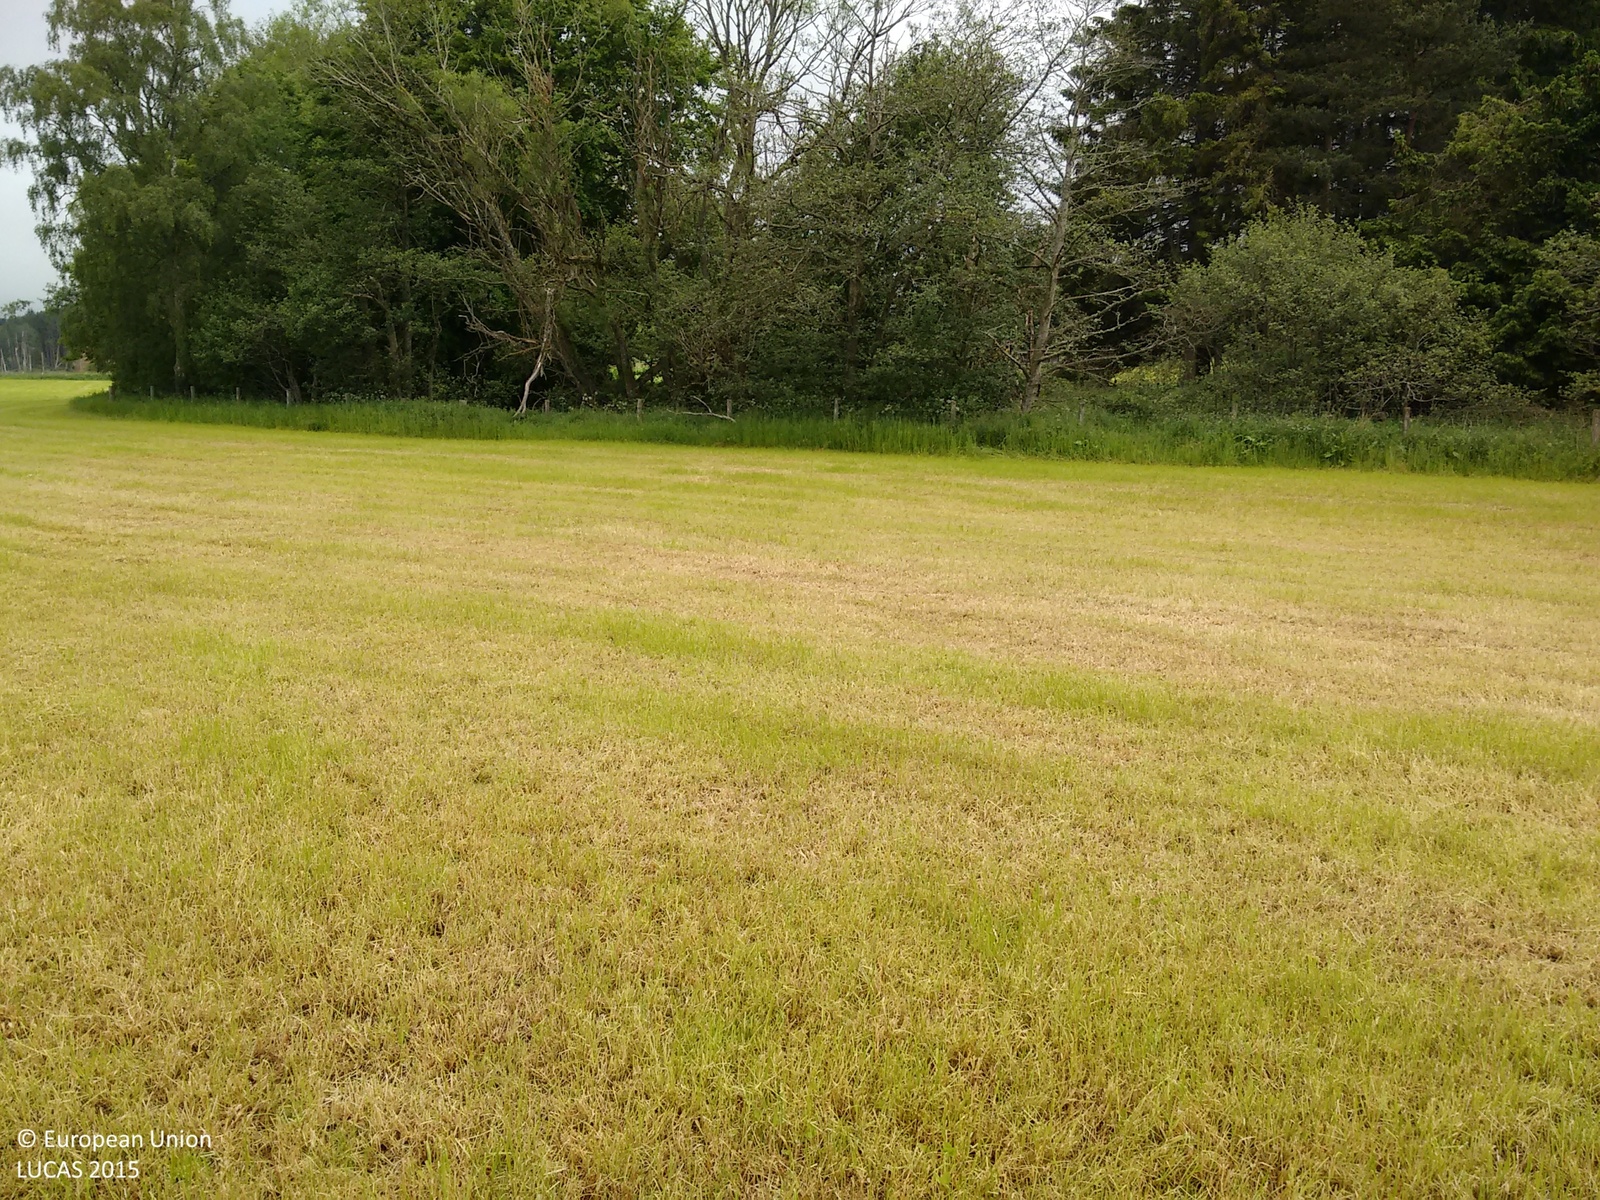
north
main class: Grassland
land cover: Grassland without tree/shrub cover
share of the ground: > 75 %
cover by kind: herbaceous plants 100 %
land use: Agriculture (excluding fallow land and kitchen gardens)
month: June
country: GB
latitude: 57.1173
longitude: -2.9267
